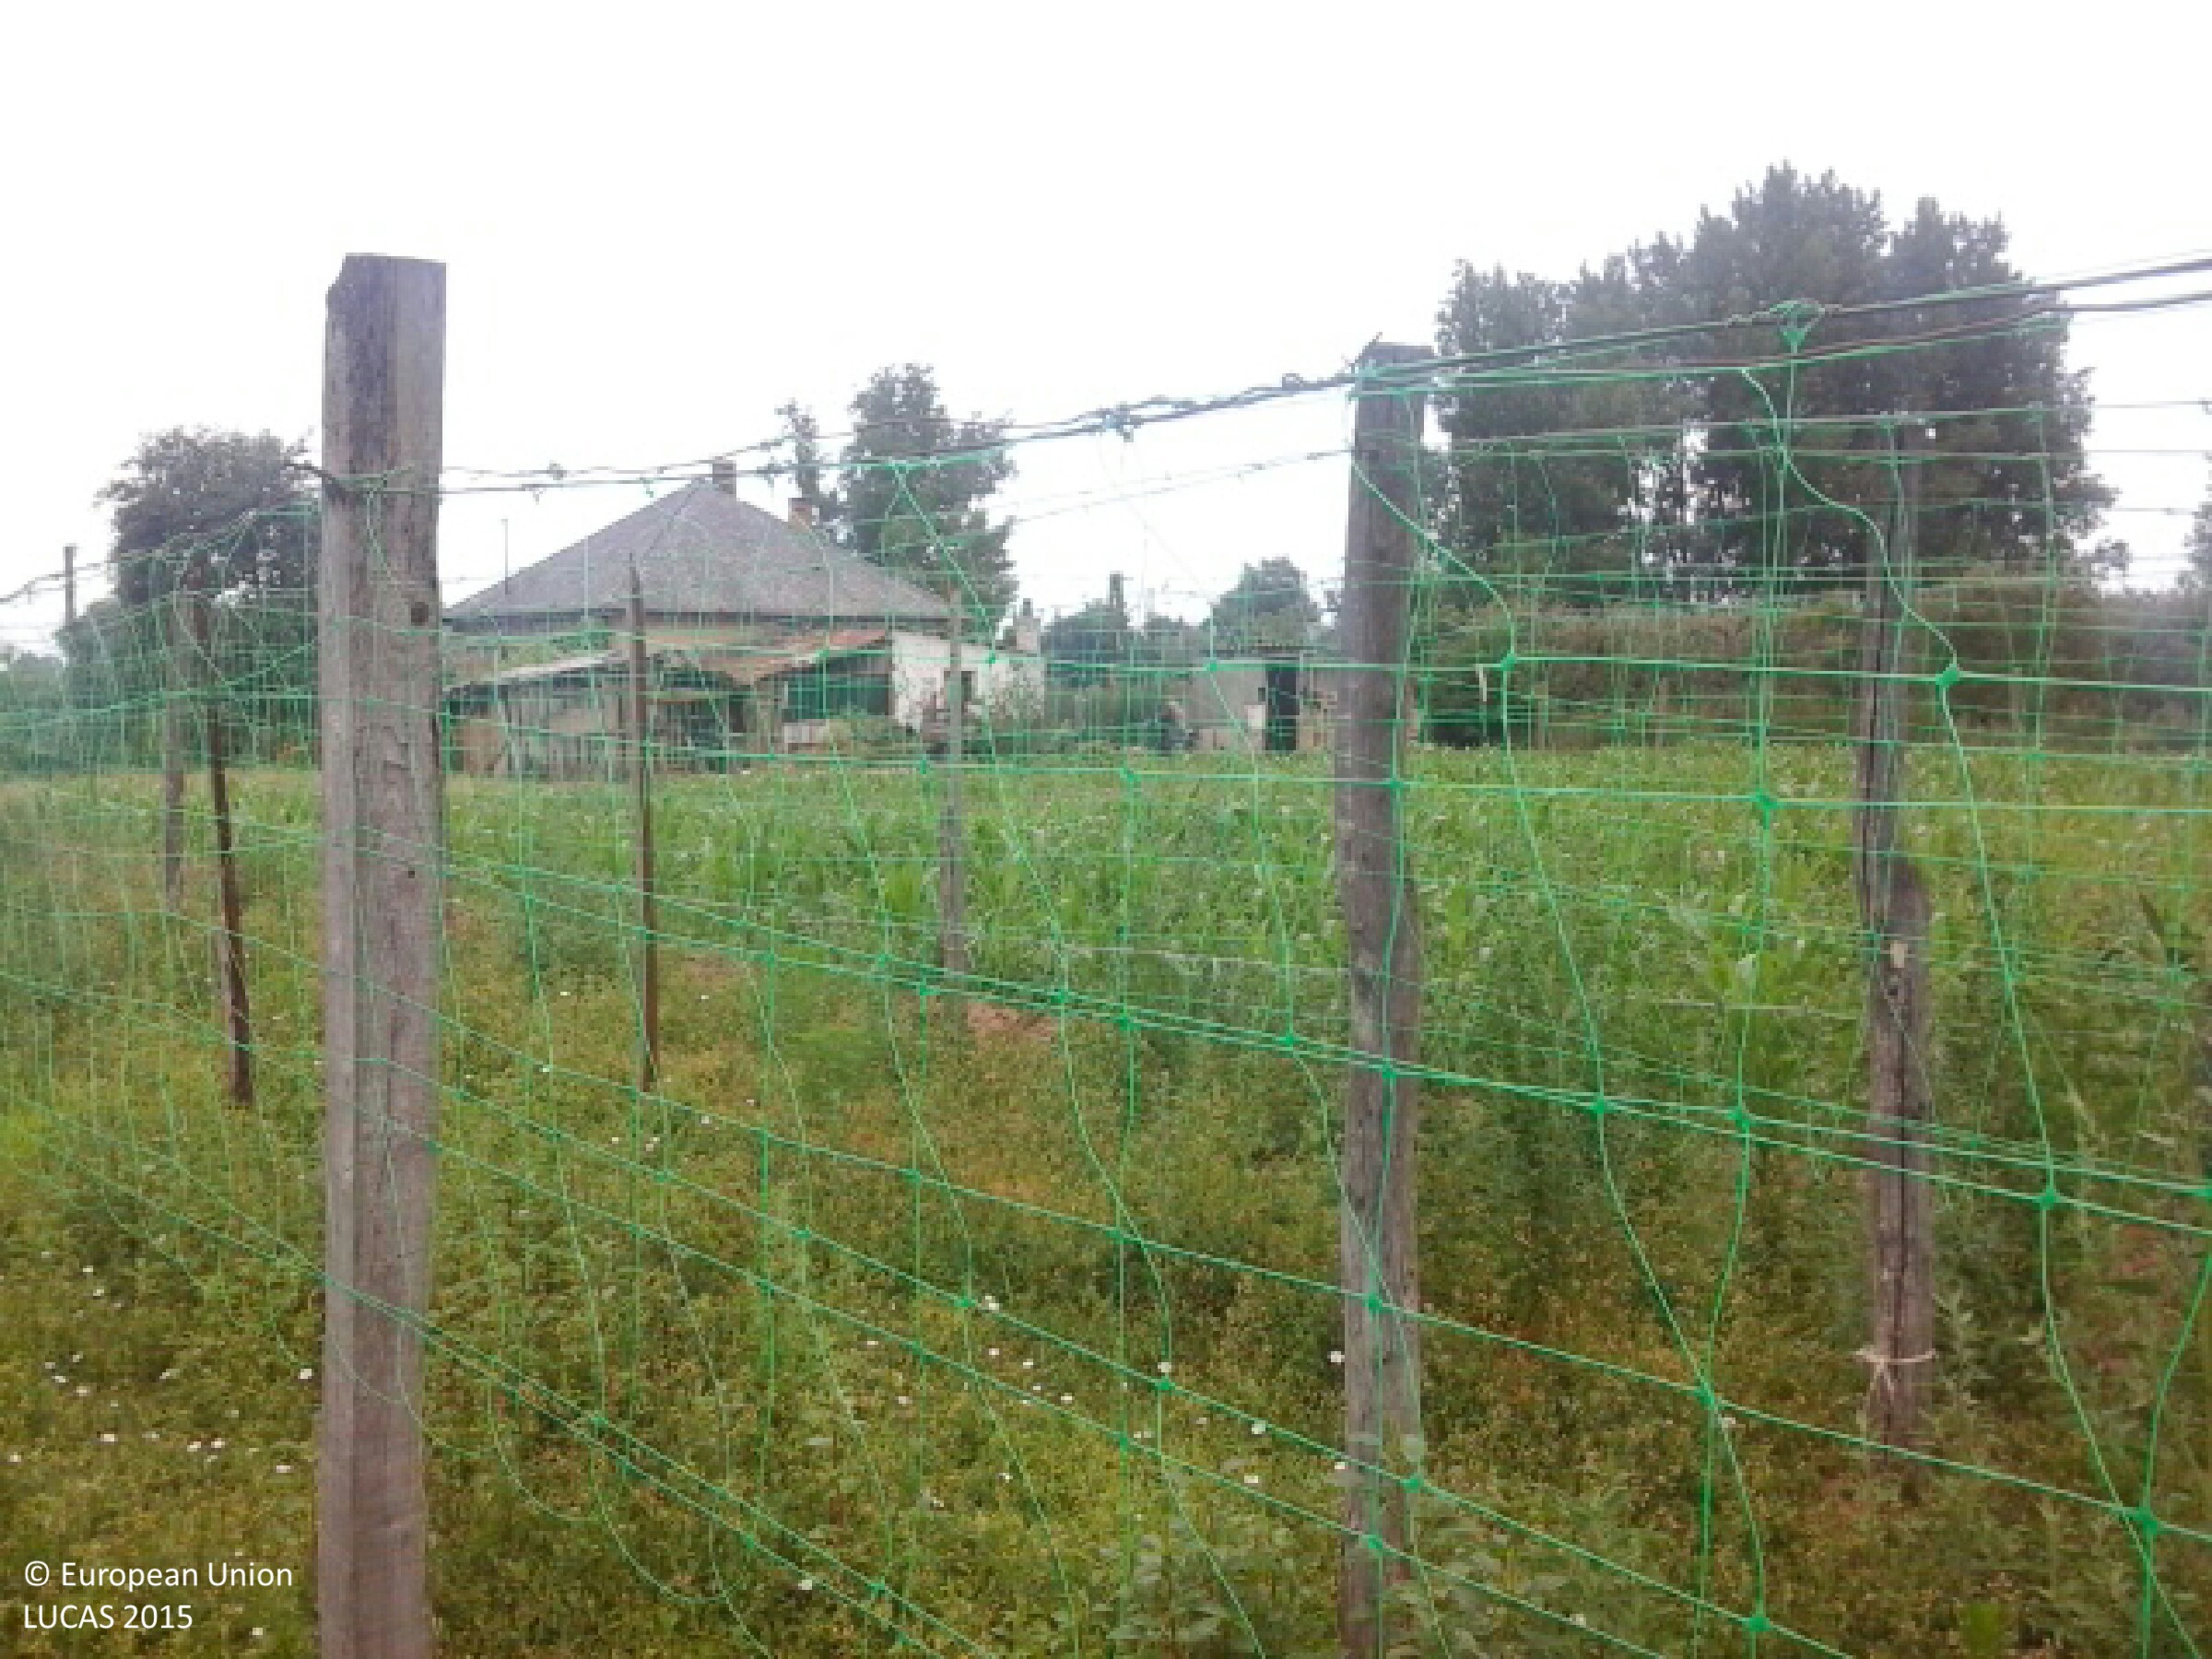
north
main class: Grassland
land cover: Spontaneously vegetated surfaces
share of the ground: > 75 %
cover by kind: herbaceous plants 100 %
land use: Fallow land
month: June
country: HU
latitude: 47.9820
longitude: 22.1797
